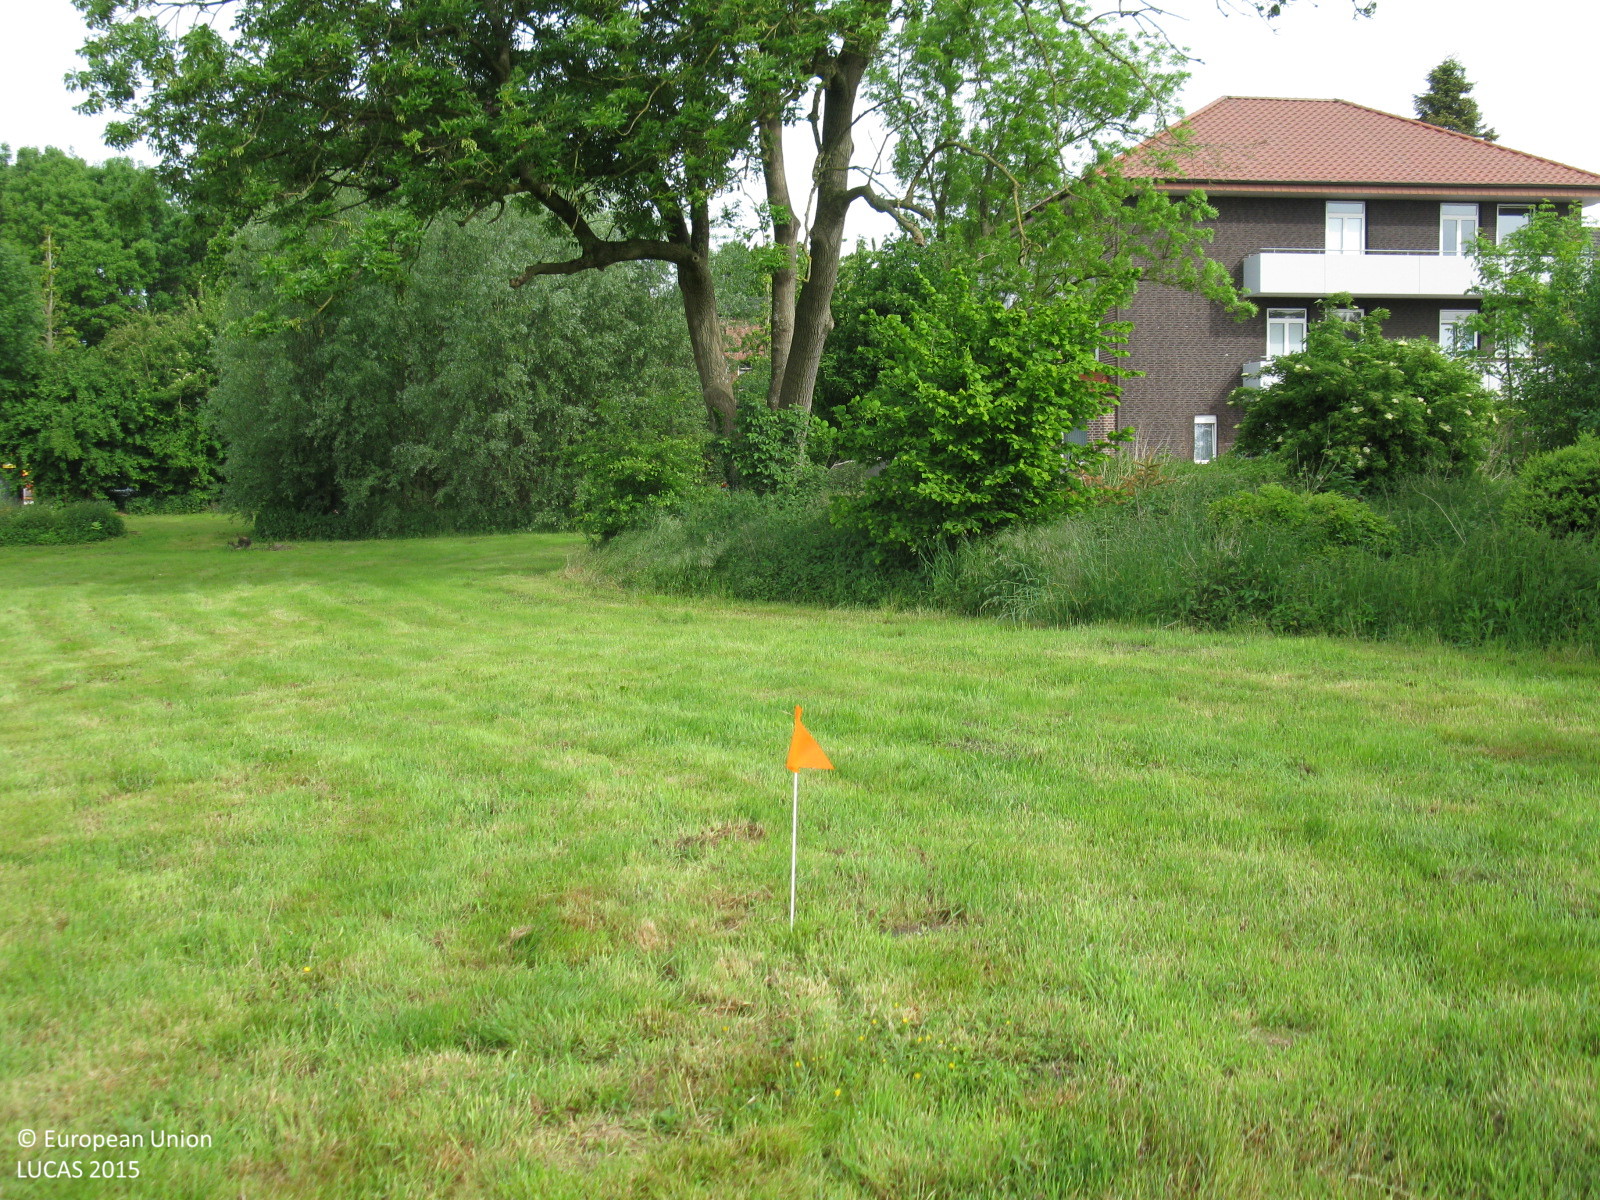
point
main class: Grassland
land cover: Grassland without tree/shrub cover
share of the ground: > 75 %
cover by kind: herbaceous plants 100 %
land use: Residential
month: June
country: DE
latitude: 53.0488
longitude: 7.3303
